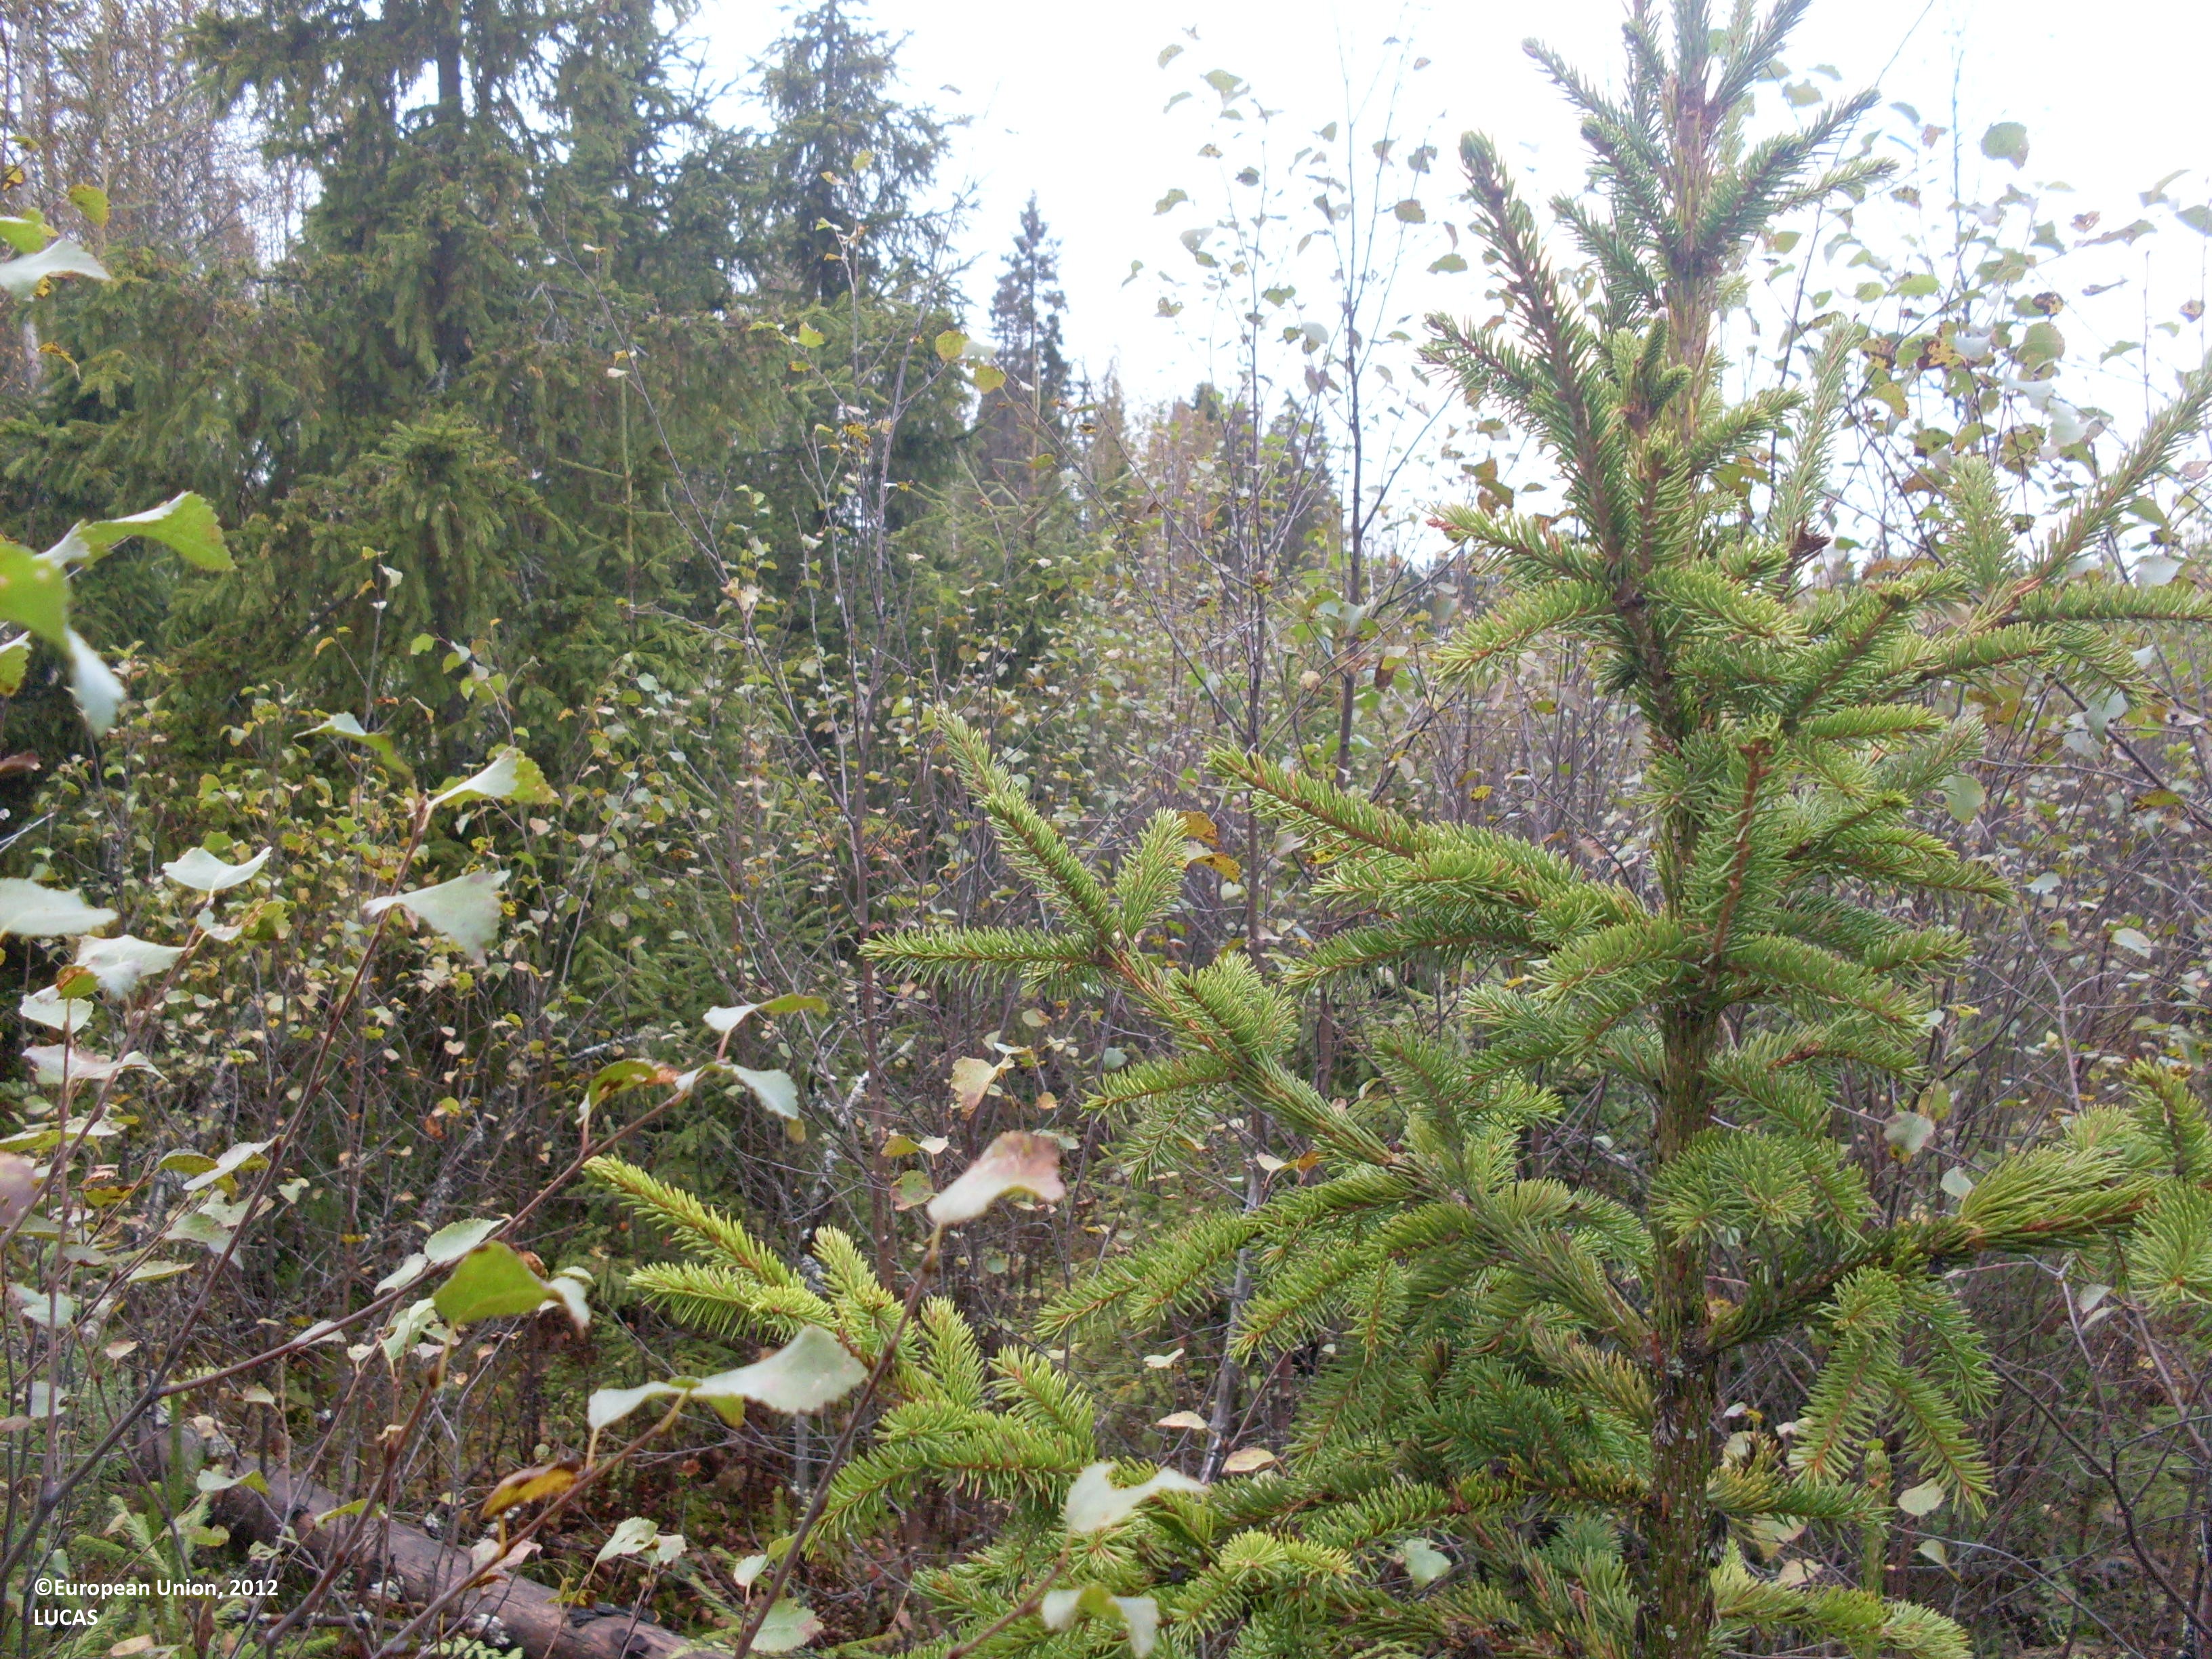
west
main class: Shrubland
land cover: Shrubland with sparse tree cover
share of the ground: > 75 %
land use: Forestry
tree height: < 5 m
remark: Clear cut
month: September
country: FI
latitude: 64.1753
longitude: 28.4704
